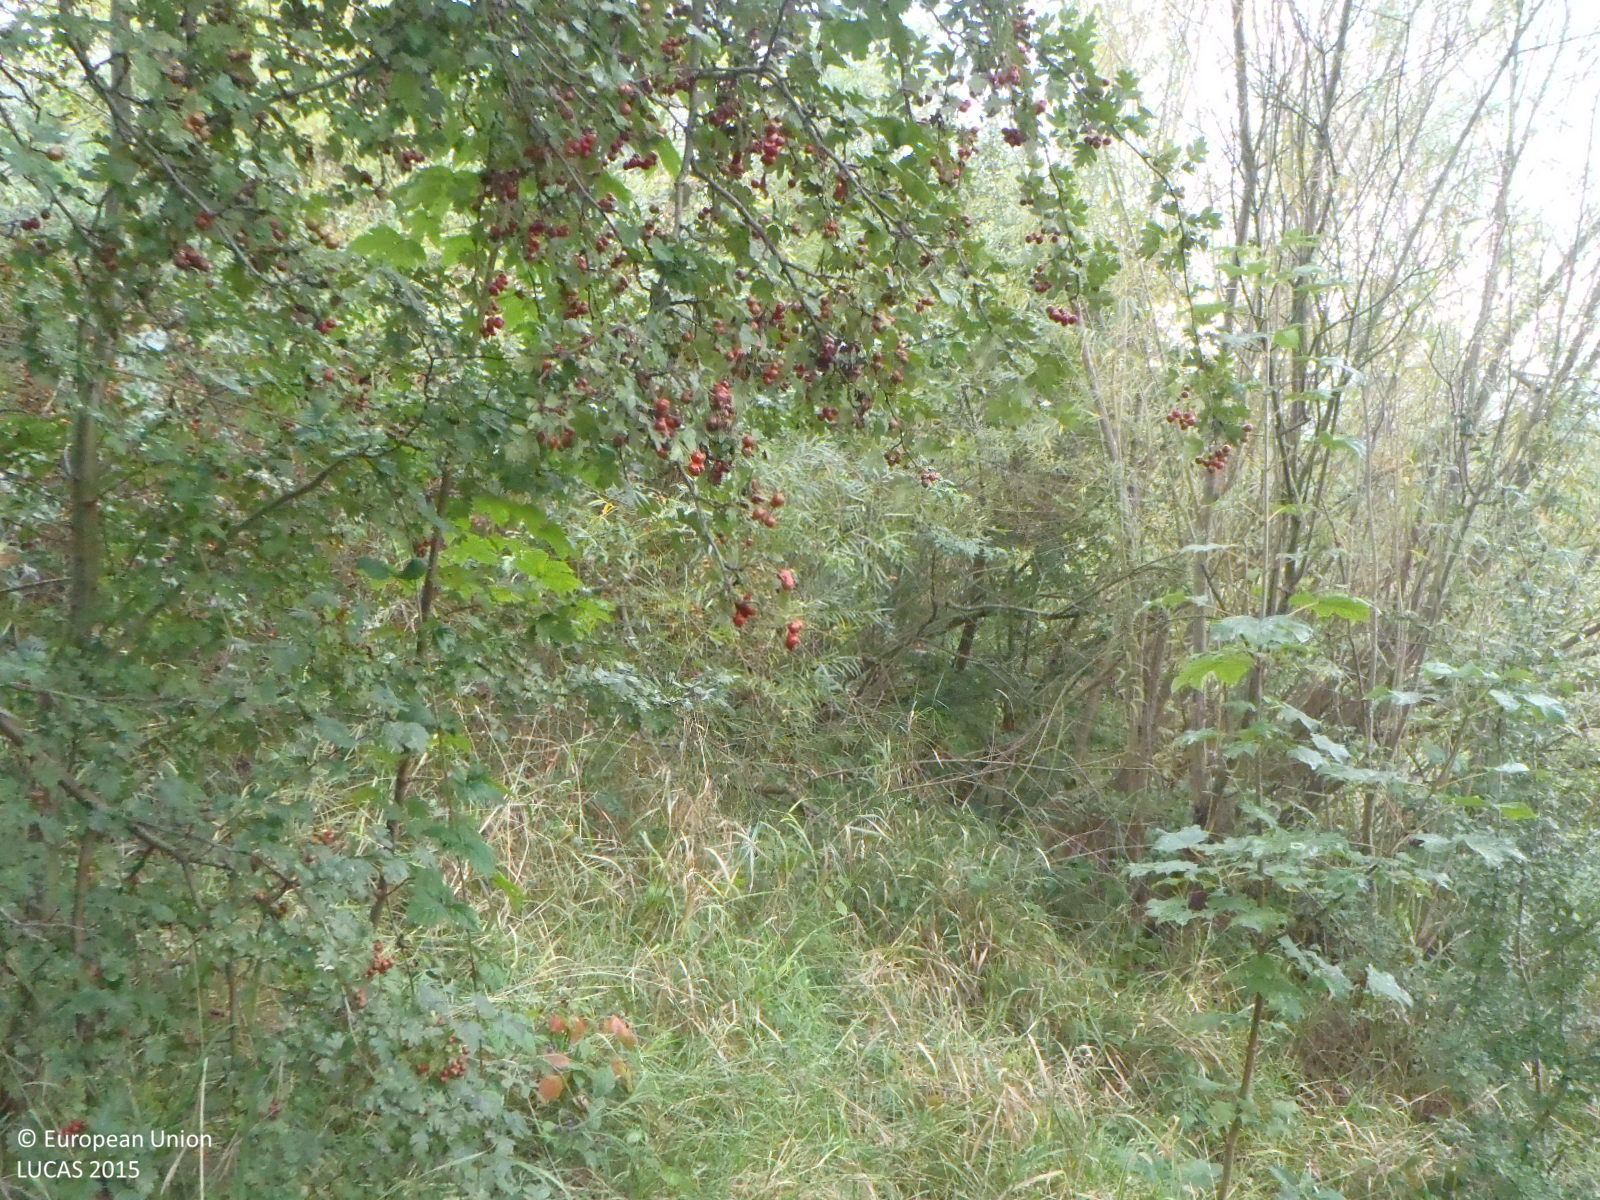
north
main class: Woodland
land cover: Broadleaved woodland
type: floodplain forest
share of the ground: > 75 %
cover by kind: broadleaved forest trees 80 %, shrubs 10 %, herbaceous plants 10 %
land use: Semi-natural and natural areas not in use
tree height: > 5 m
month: September
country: CZ
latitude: 50.6579
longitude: 13.8909
